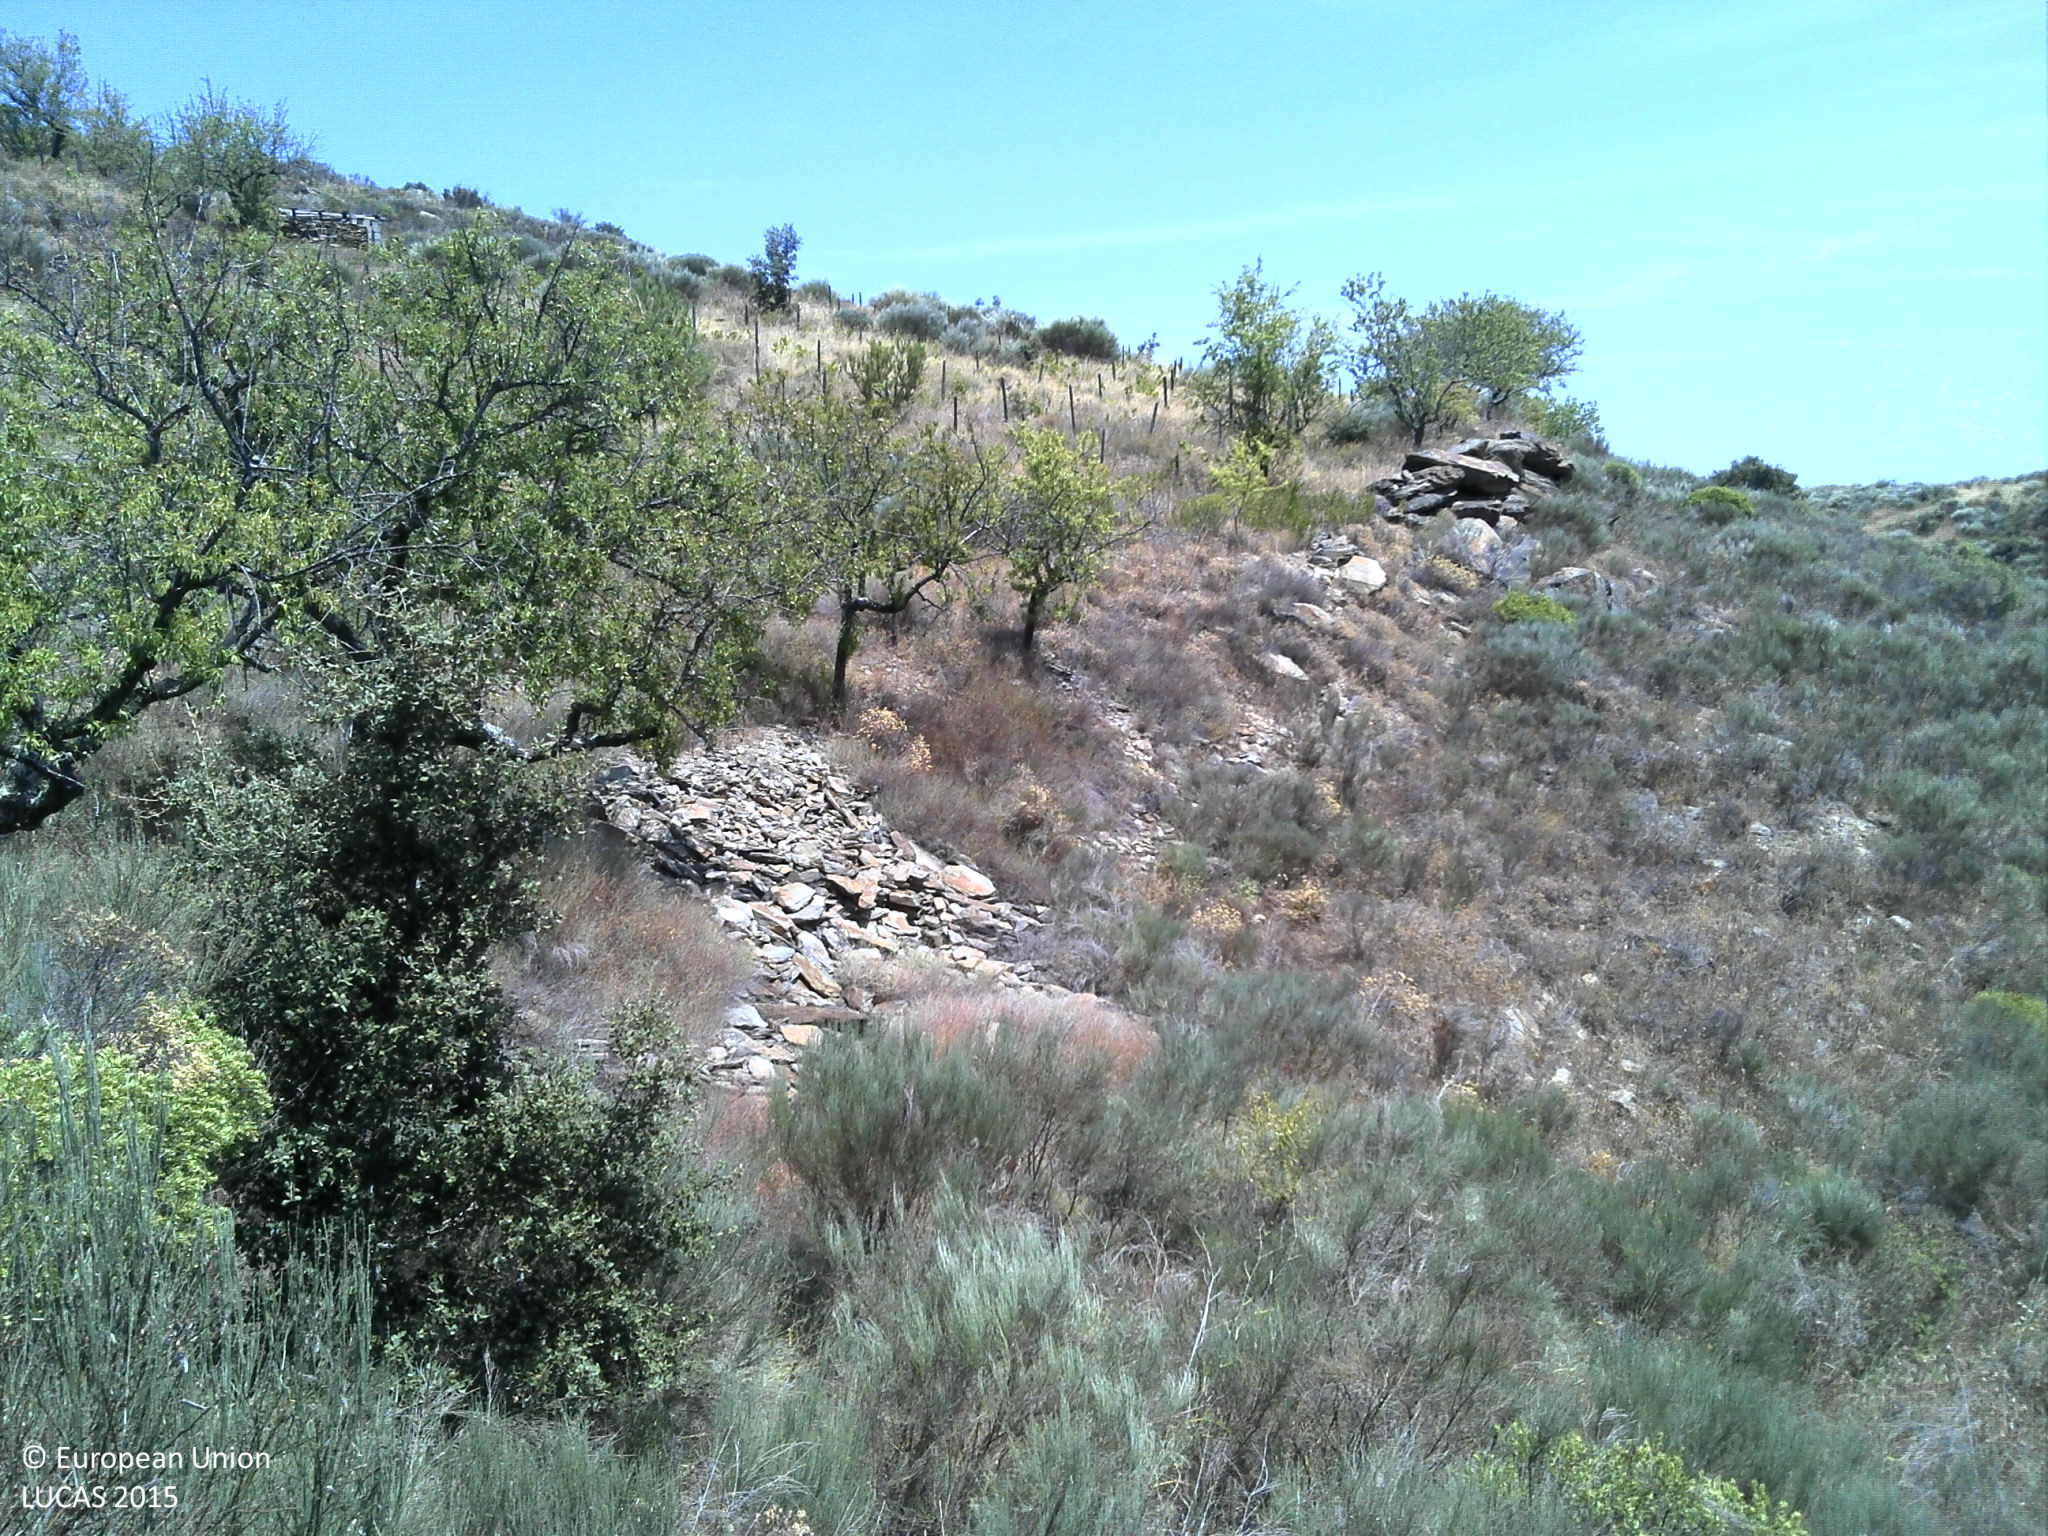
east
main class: Shrubland
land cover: Shrubland without tree cover
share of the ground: > 75 %
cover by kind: shrubs 100 %
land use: Semi-natural and natural areas not in use
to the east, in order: Shrubland without tree cover; Nuts trees; Vineyards; Shrubland with sparse tree cover; Shrubland without tree cover; Dry stone walls; Shrubland without tree cover; Tracks; Shrubland without tree cover
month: July
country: PT
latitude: 41.0984
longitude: -7.3941
